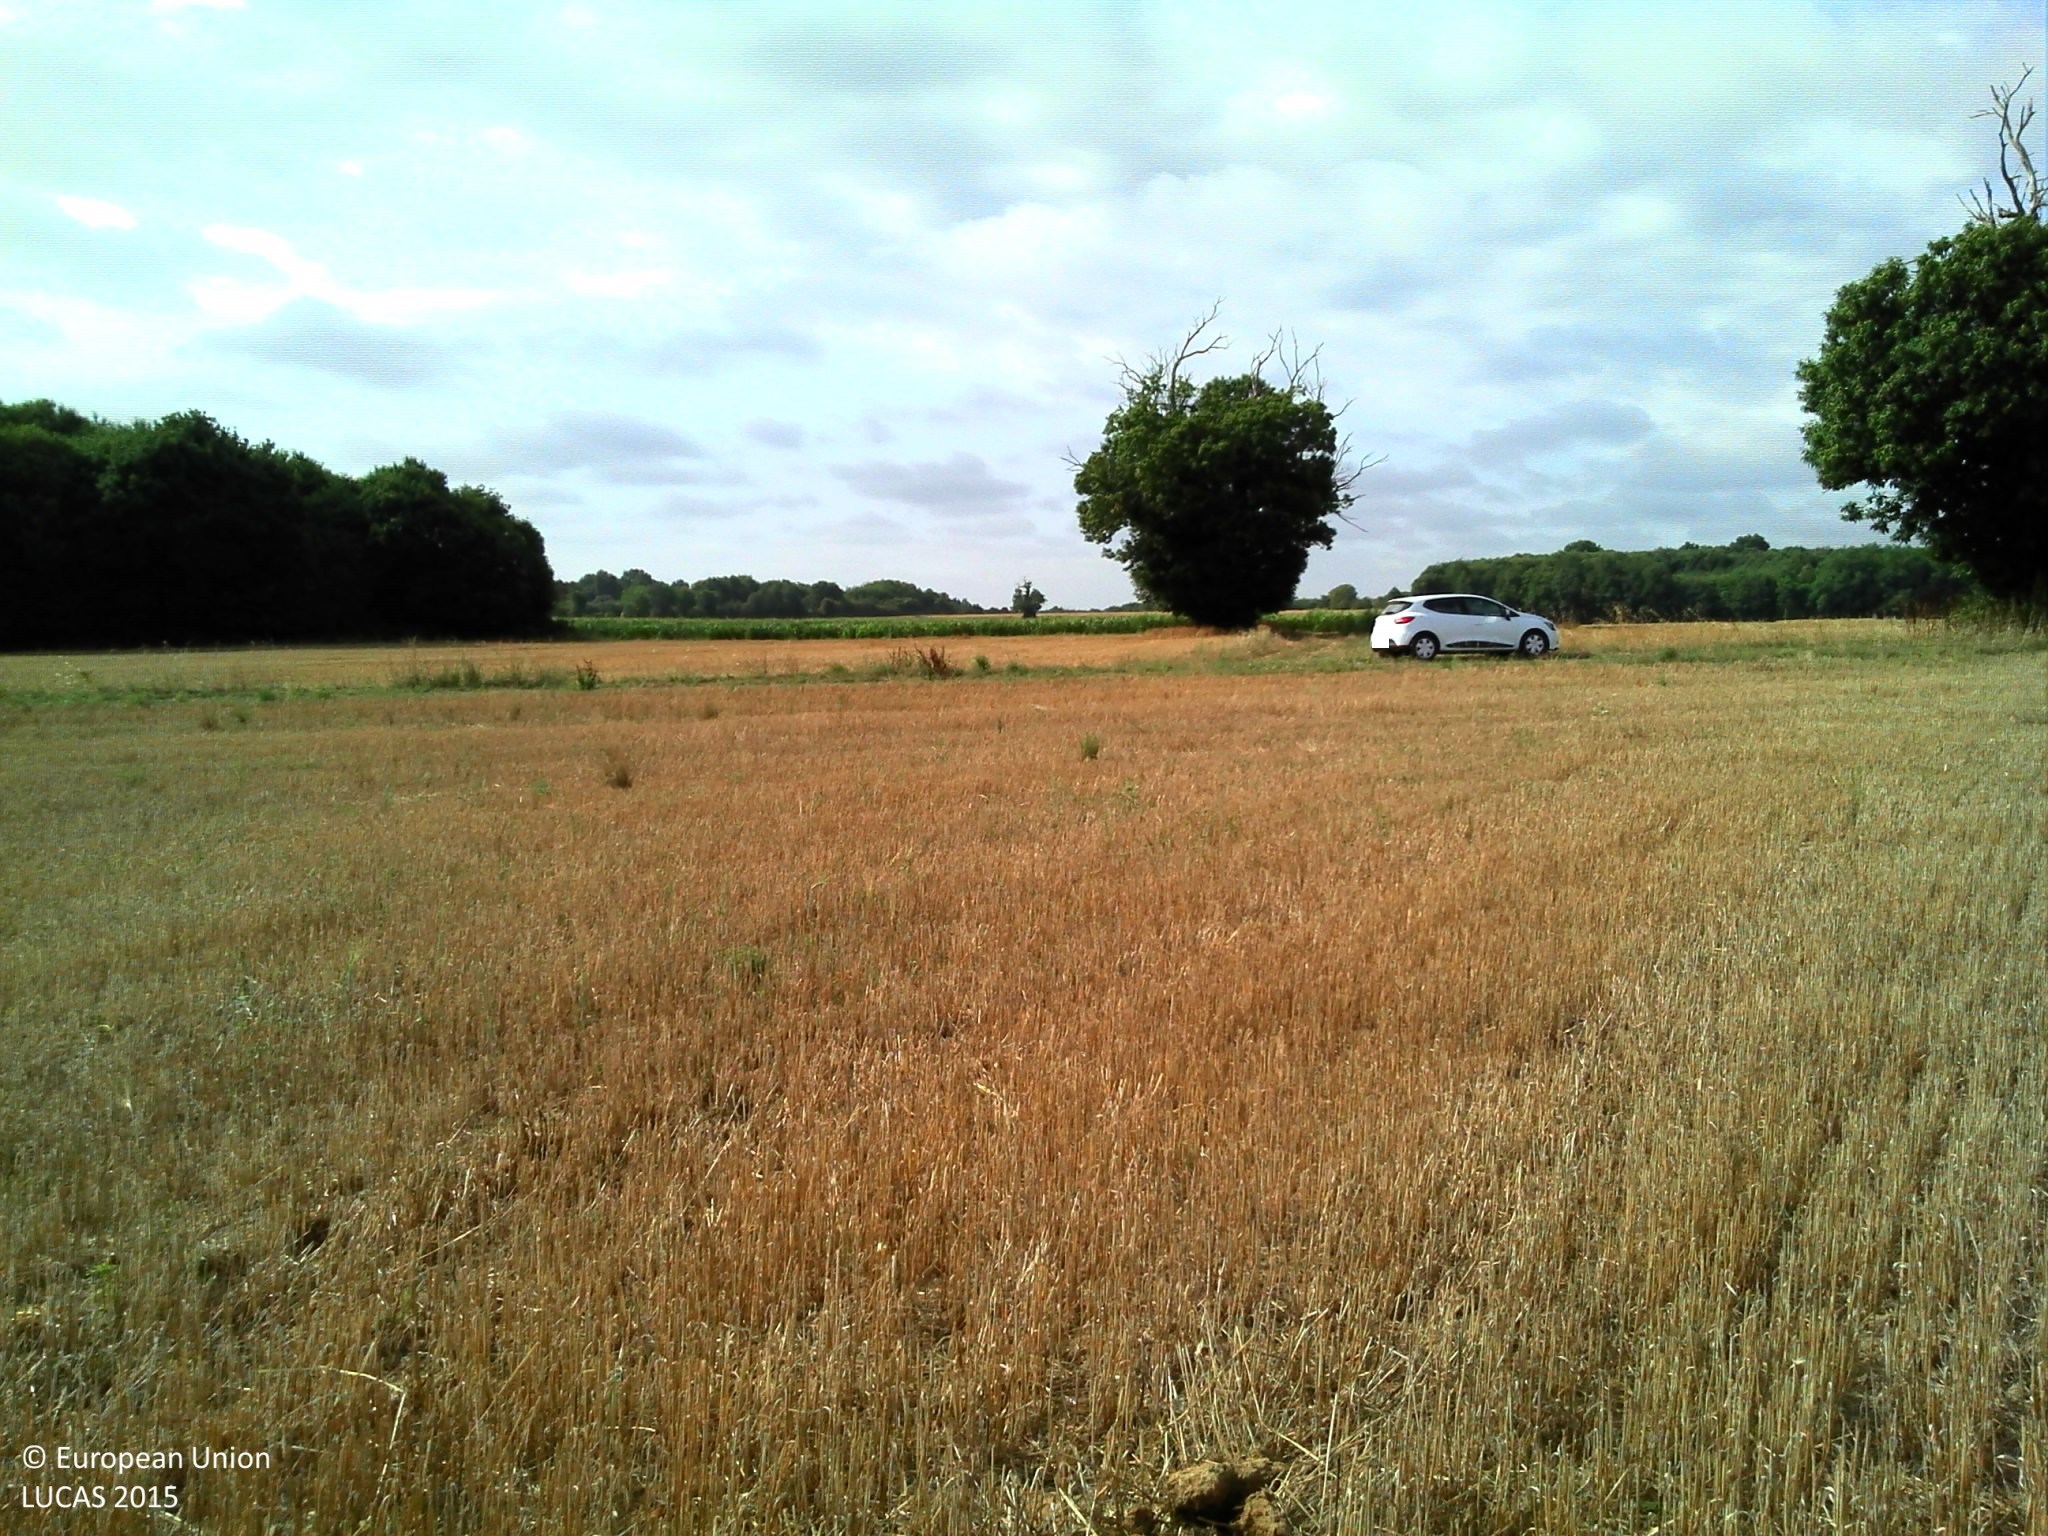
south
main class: Cropland
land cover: Common wheat
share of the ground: > 75 %
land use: Agriculture (excluding fallow land and kitchen gardens)
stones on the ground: 10 - 25 %
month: August
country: FR
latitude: 46.2664
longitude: 0.2373
